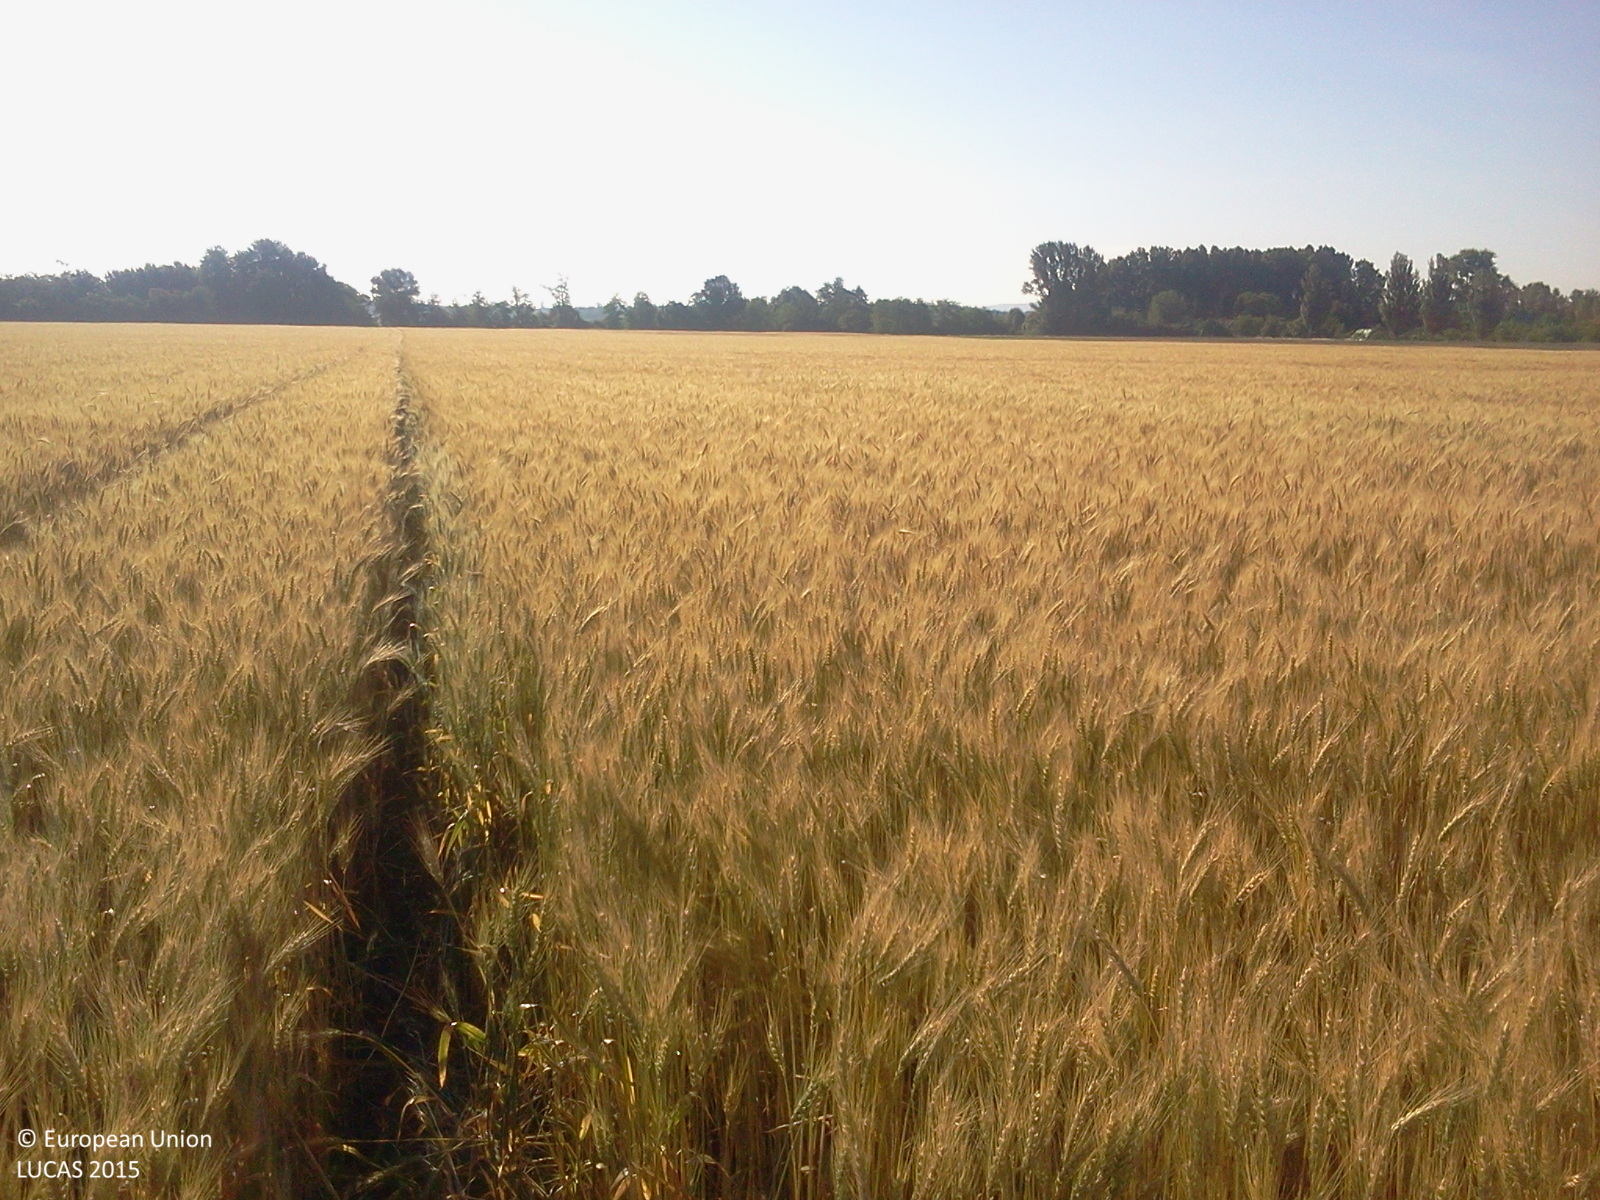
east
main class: Cropland
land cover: Durum wheat
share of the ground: > 75 %
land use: Agriculture (excluding fallow land and kitchen gardens)
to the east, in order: Durum wheat
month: June
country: HU
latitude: 47.0515
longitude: 17.1531
